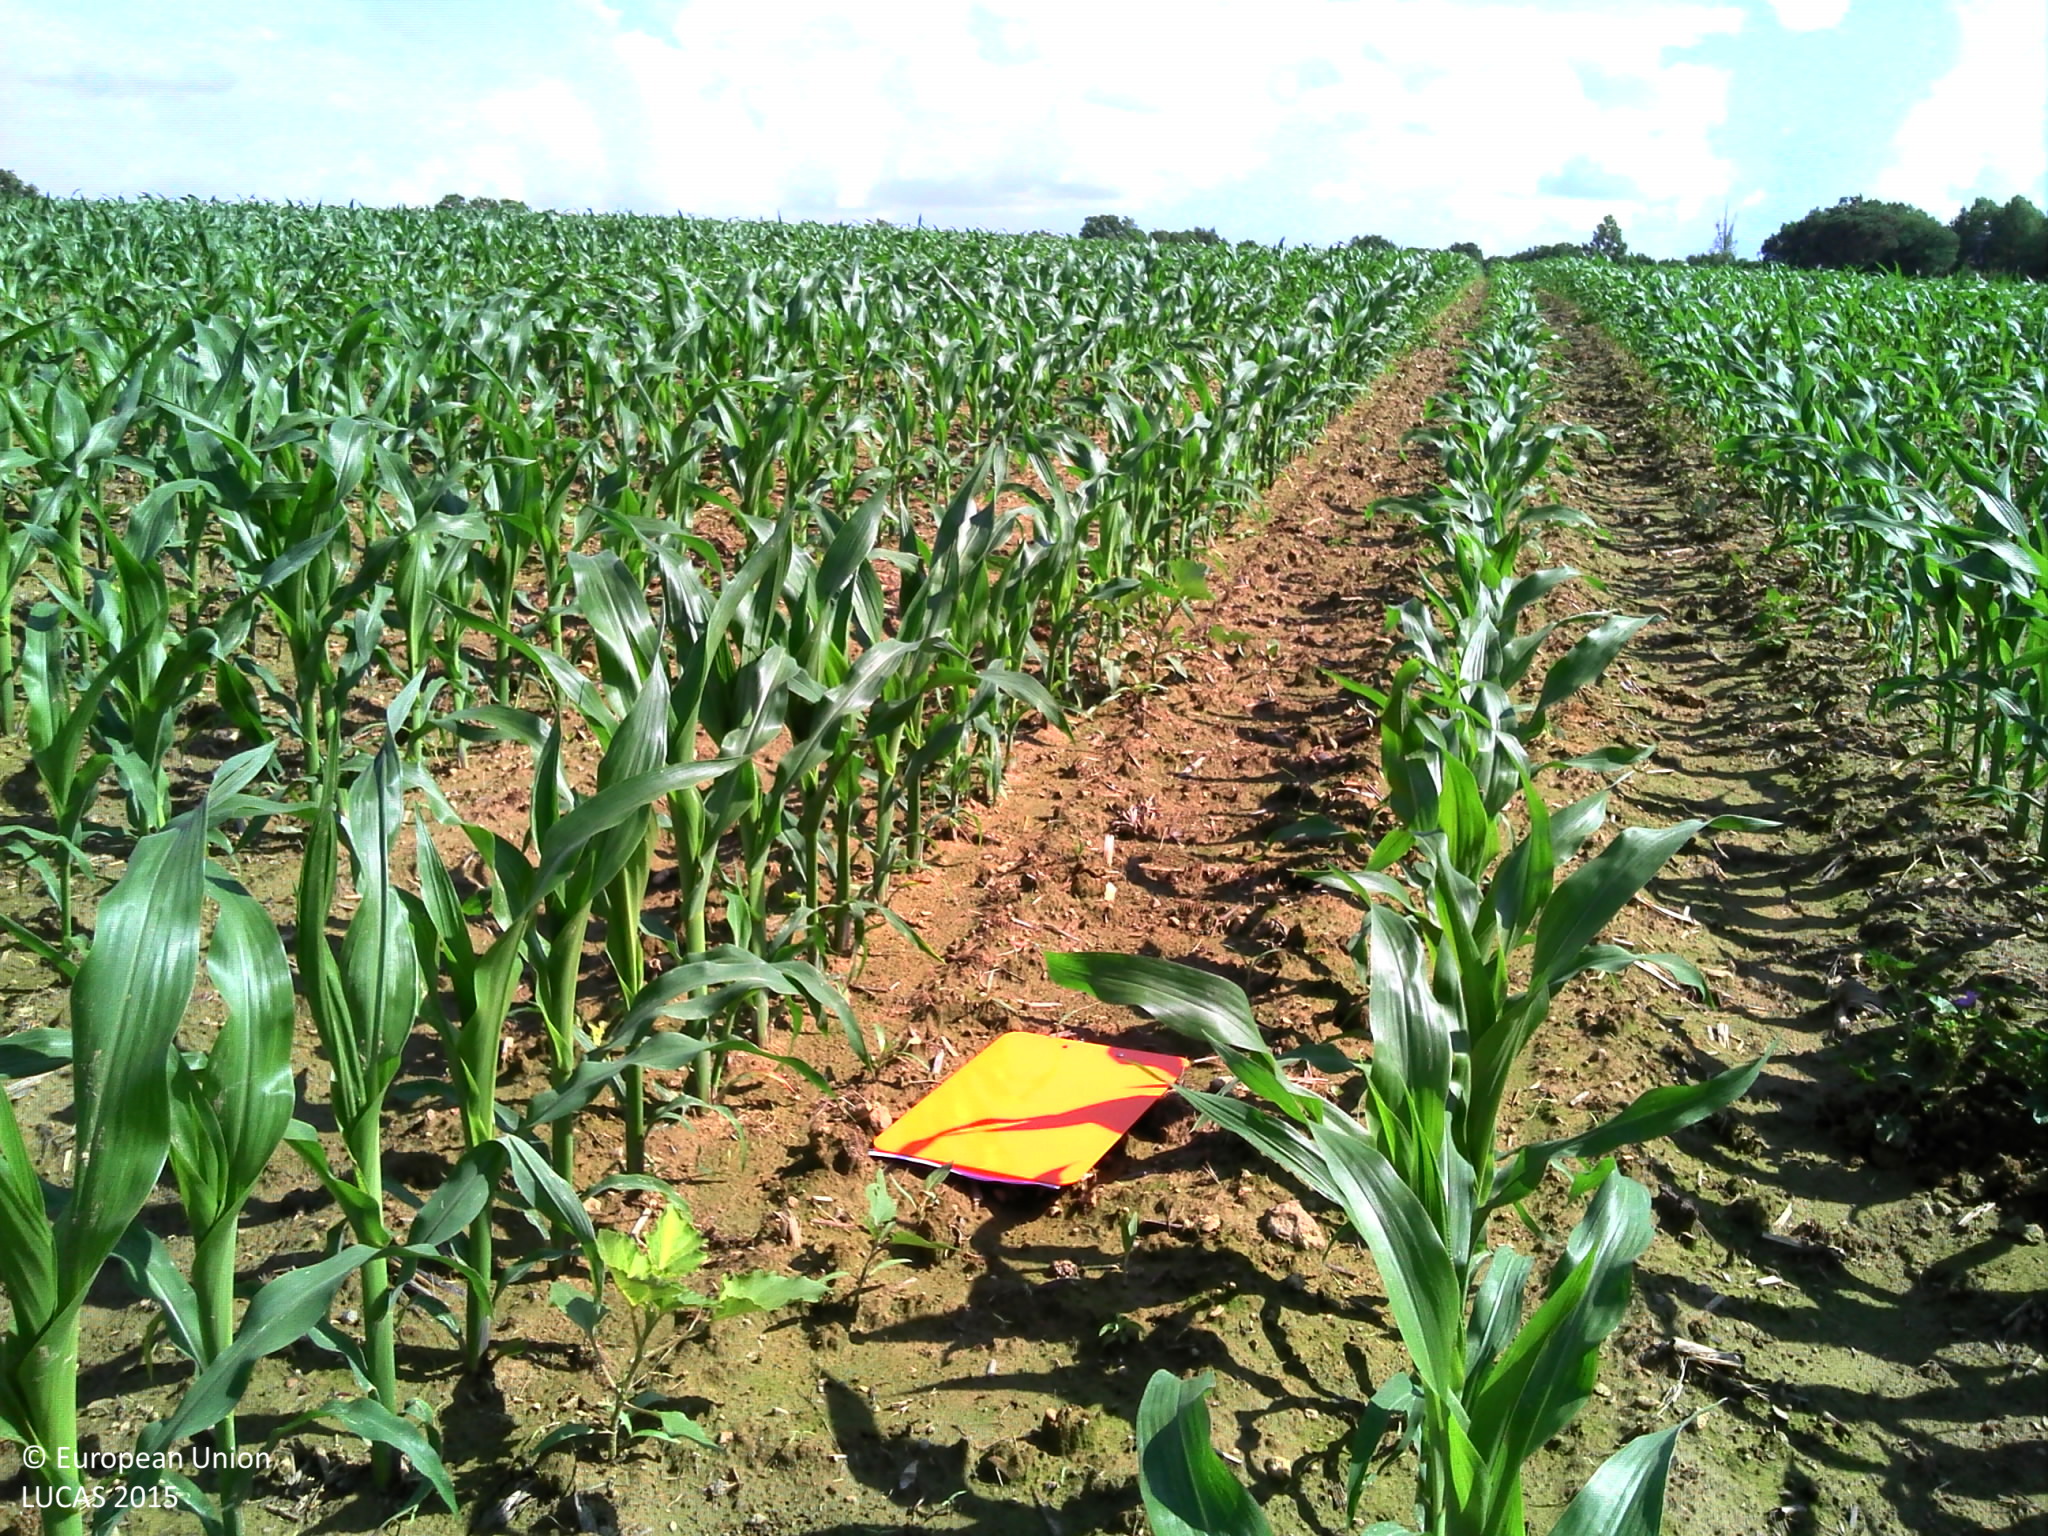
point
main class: Cropland
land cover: Maize
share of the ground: 25 - 50 %
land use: Agriculture (excluding fallow land and kitchen gardens)
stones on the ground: < 10 %
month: June
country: FR
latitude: 43.8064
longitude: -0.2395
